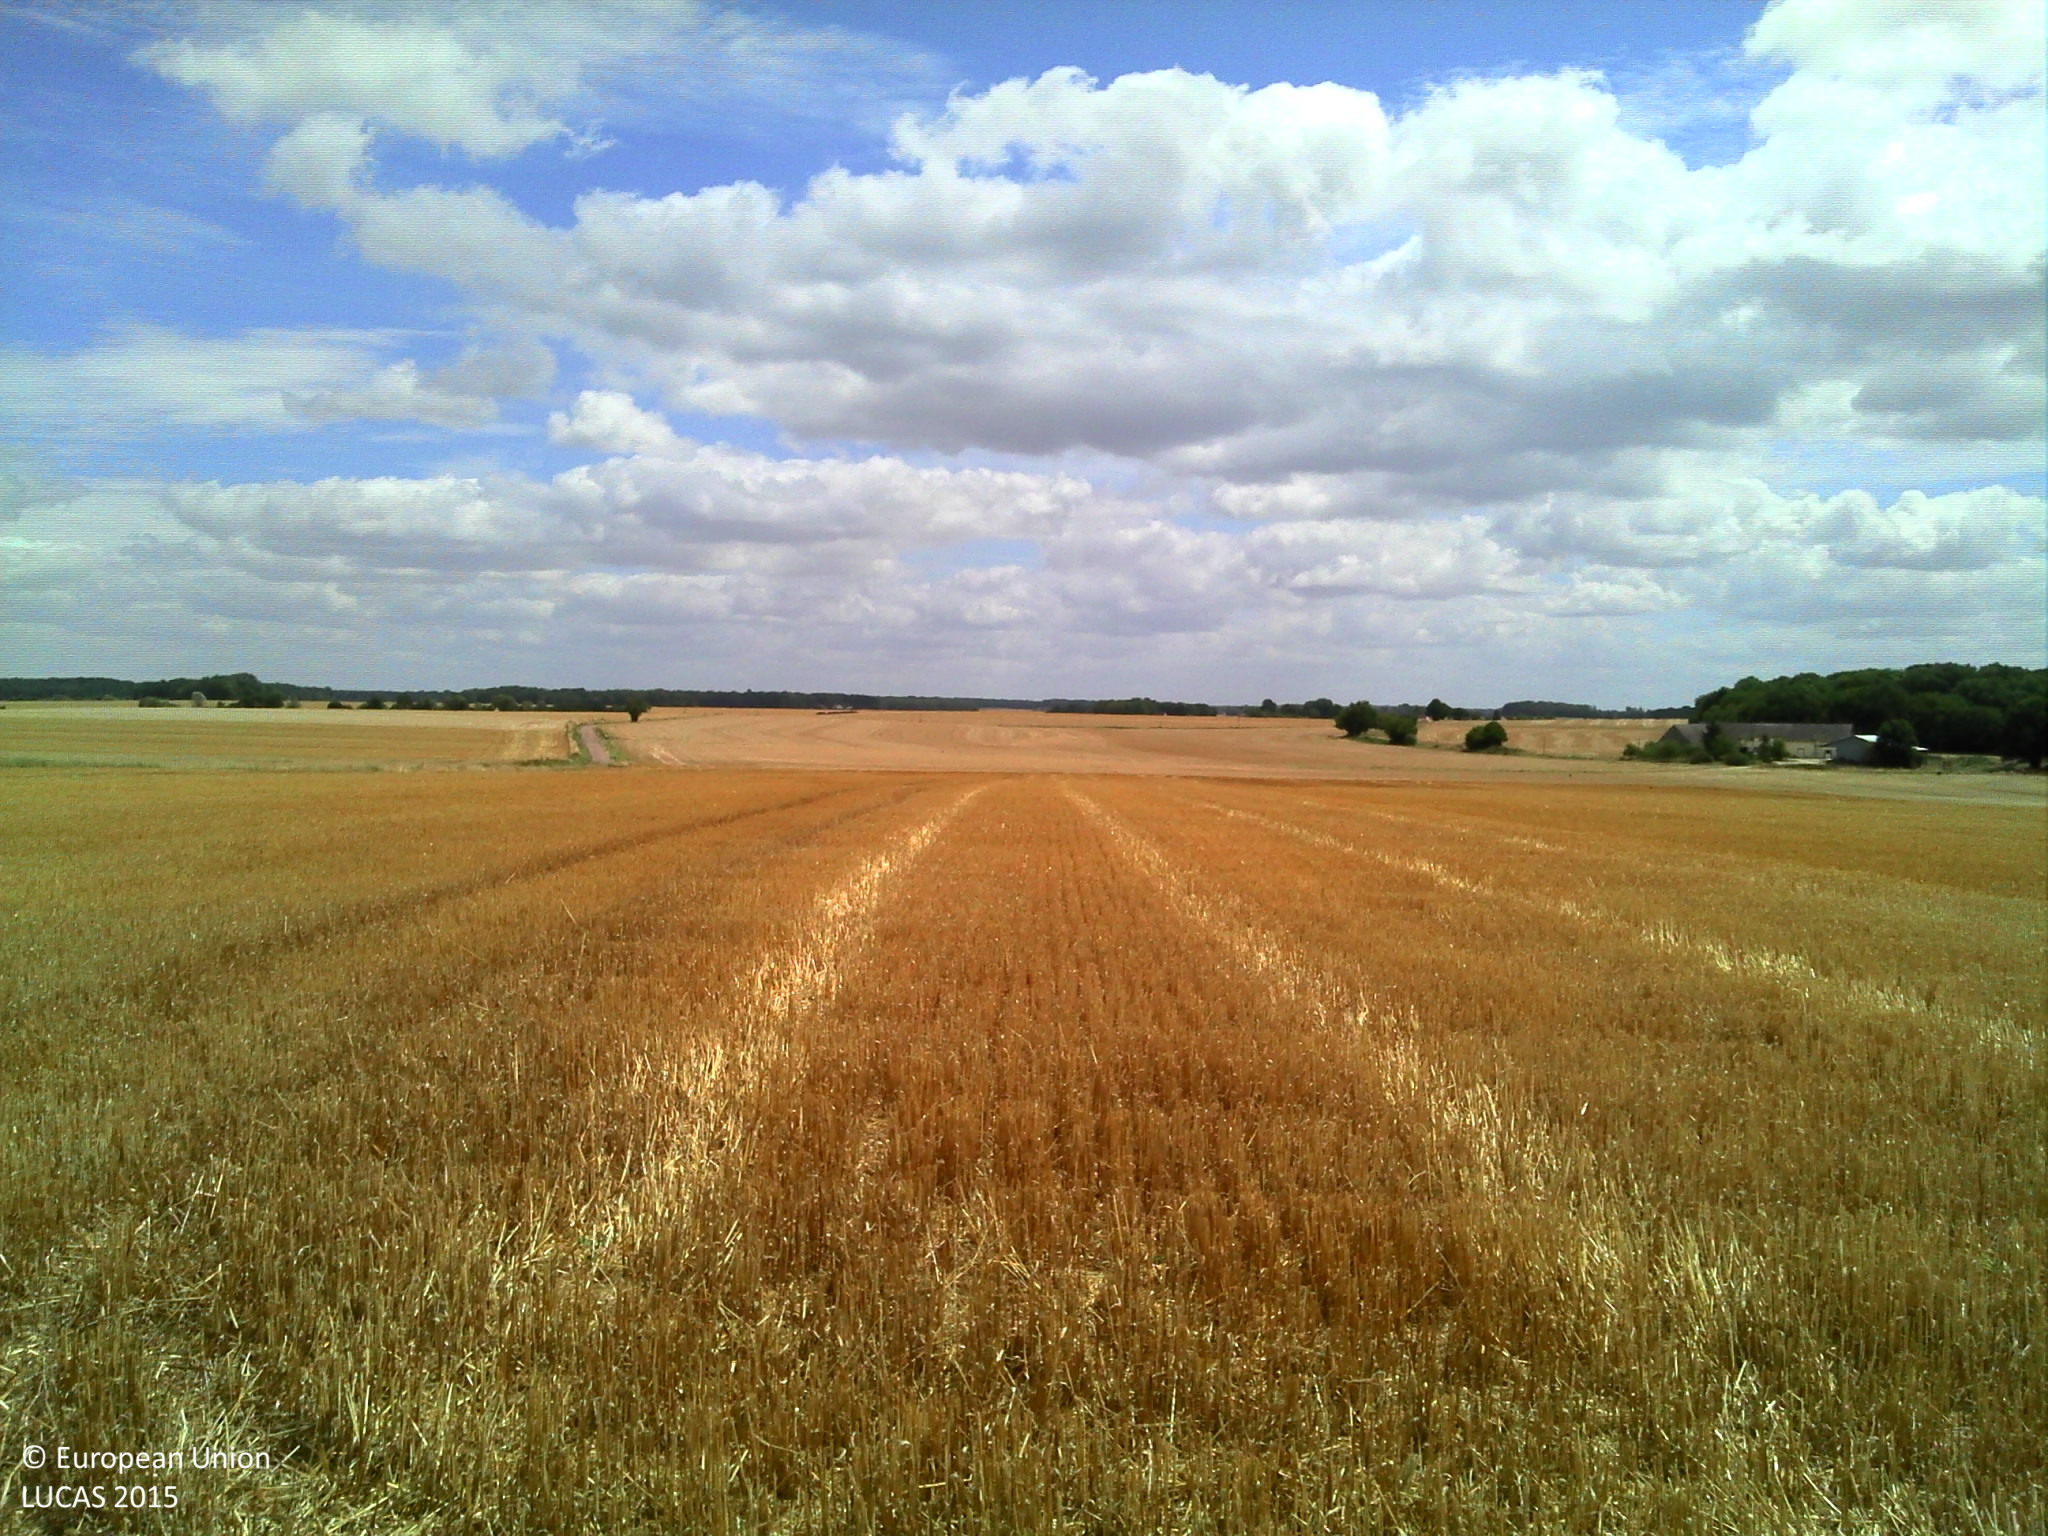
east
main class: Cropland
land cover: Barley
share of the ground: > 75 %
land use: Agriculture (excluding fallow land and kitchen gardens)
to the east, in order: Barley
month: July
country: FR
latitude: 47.8813
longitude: 3.1071
